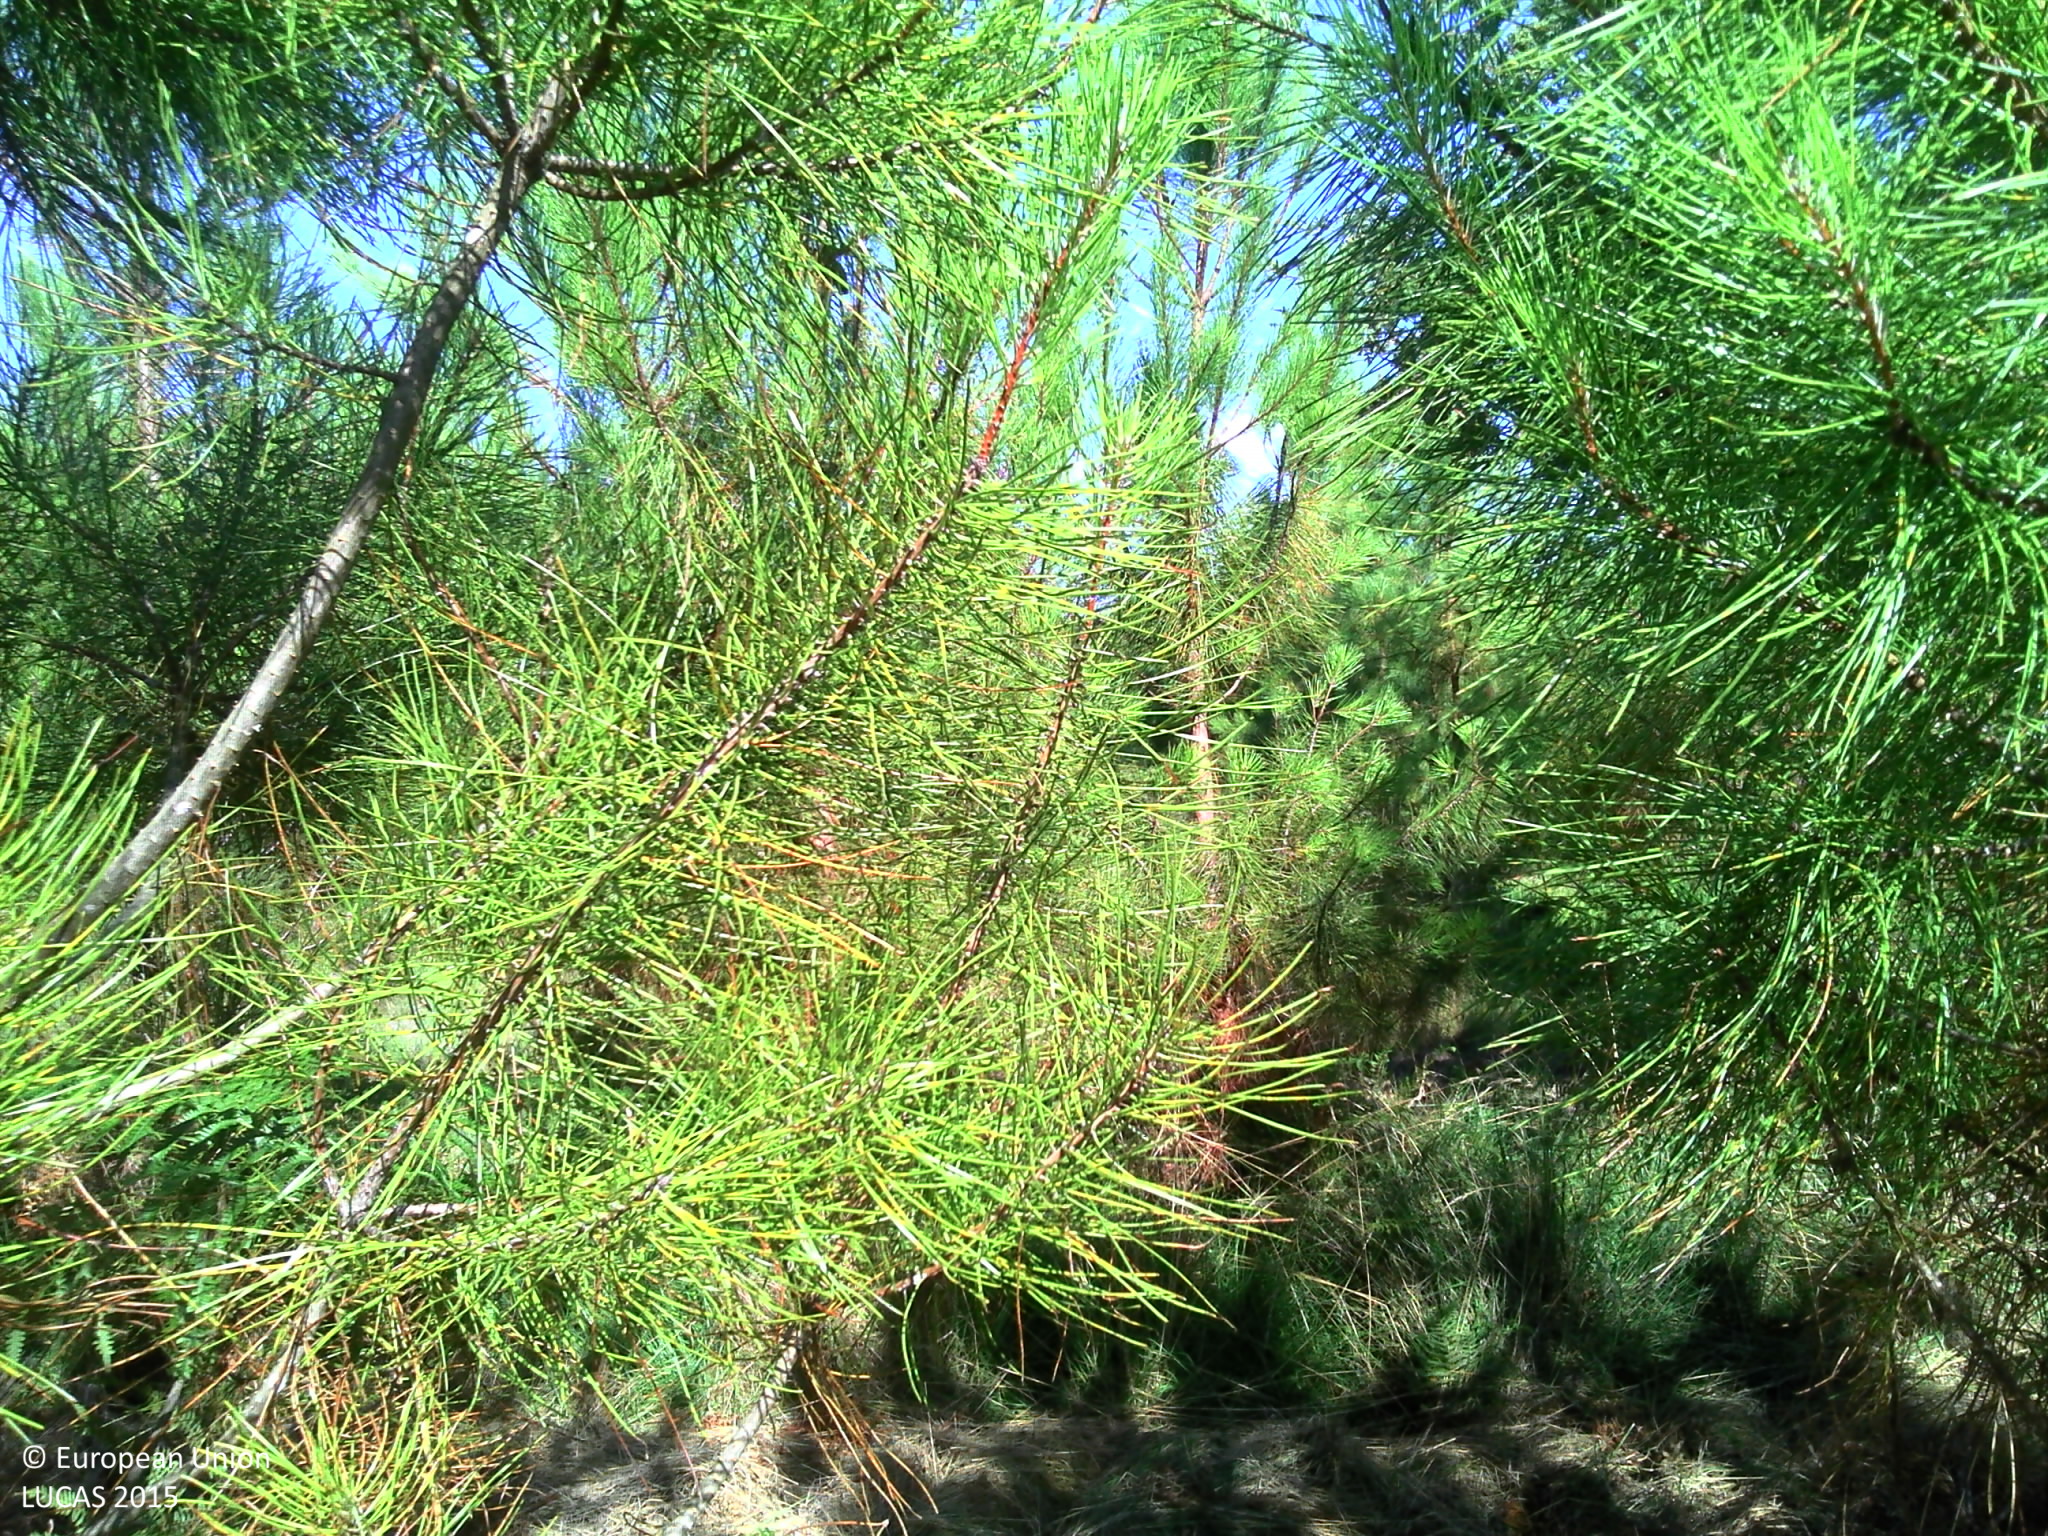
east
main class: Woodland
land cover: Pine dominated coniferous woodland
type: coniferous forest of the mediterranean region
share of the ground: > 75 %
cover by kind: coniferous forest trees 85 %, herbaceous plants 15 %
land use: Forestry
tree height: < 5 m
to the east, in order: Pine dominated coniferous woodland; Grass margins; Pine dominated coniferous woodland; Lines of trees; Ditches and canals; Grass margins; Paved roads, cycling and walking lanes; Grass margins; Ditches and canals; Tracks; Maize
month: July
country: FR
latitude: 43.8428
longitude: -0.5972
